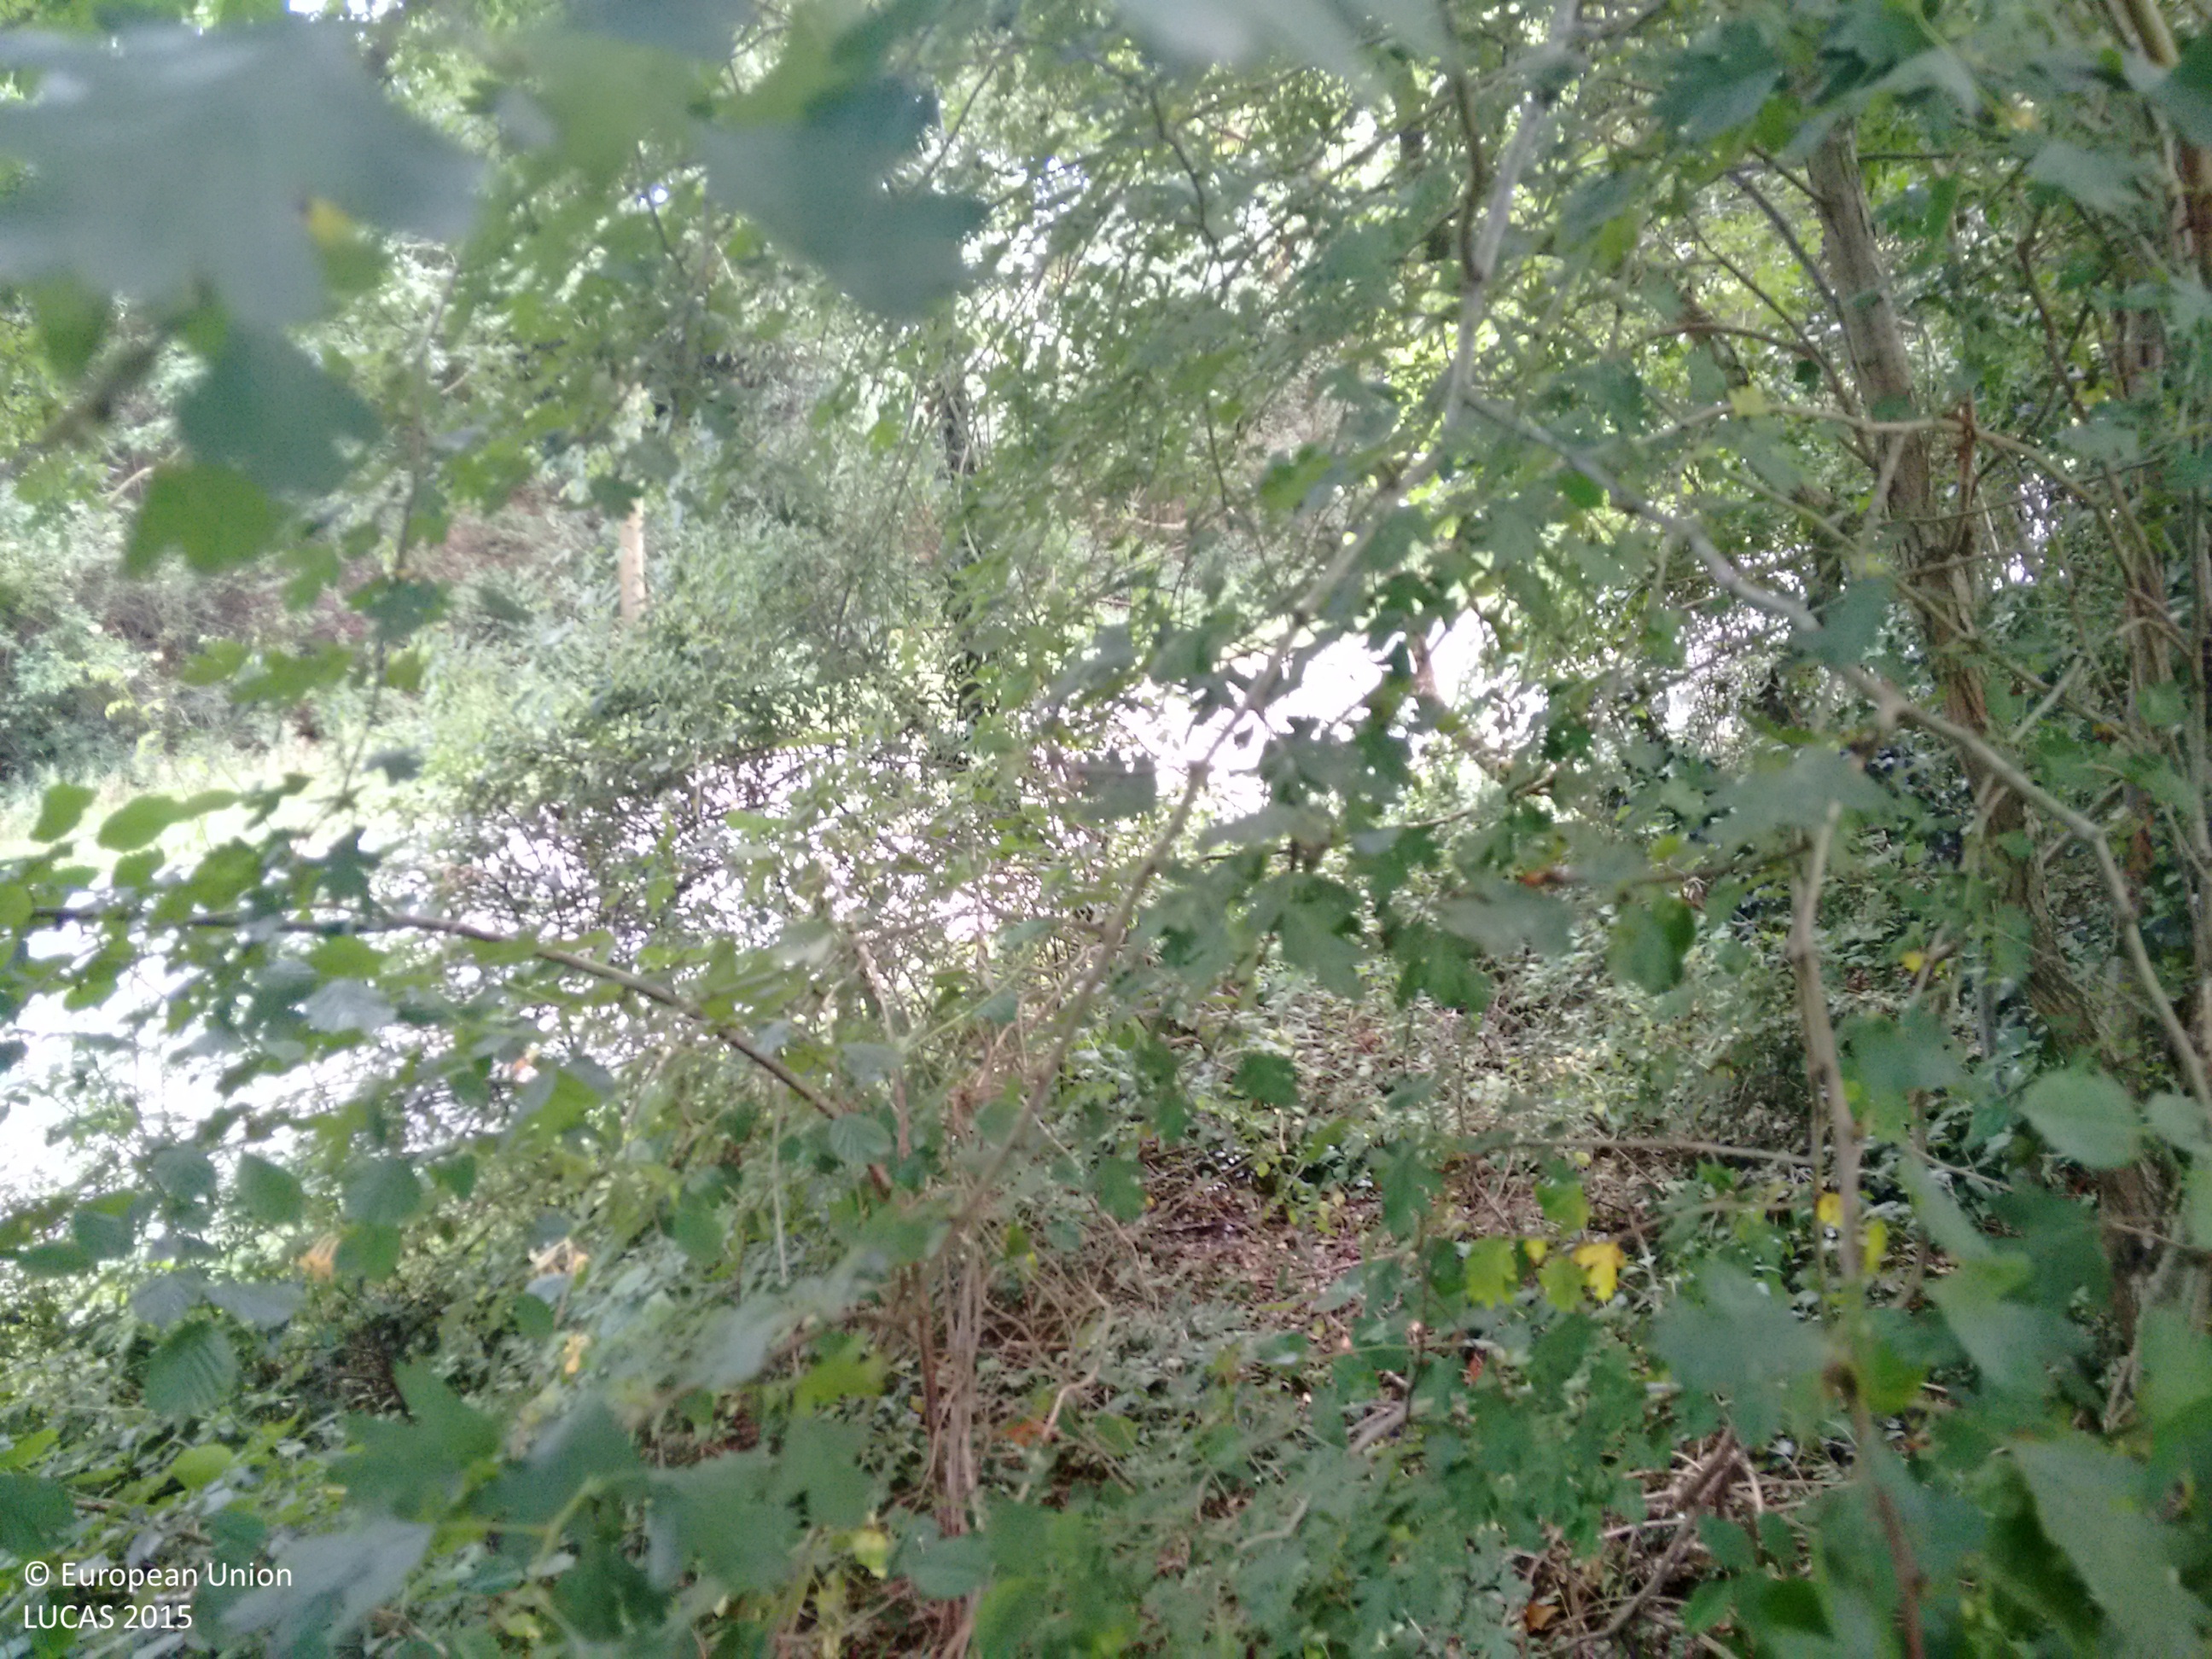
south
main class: Woodland
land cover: Broadleaved woodland
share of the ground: > 75 %
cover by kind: broadleaved forest trees 100 %
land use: Agriculture (excluding fallow land and kitchen gardens)
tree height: > 5 m
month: July
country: GB
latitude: 51.0204
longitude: -0.5166
